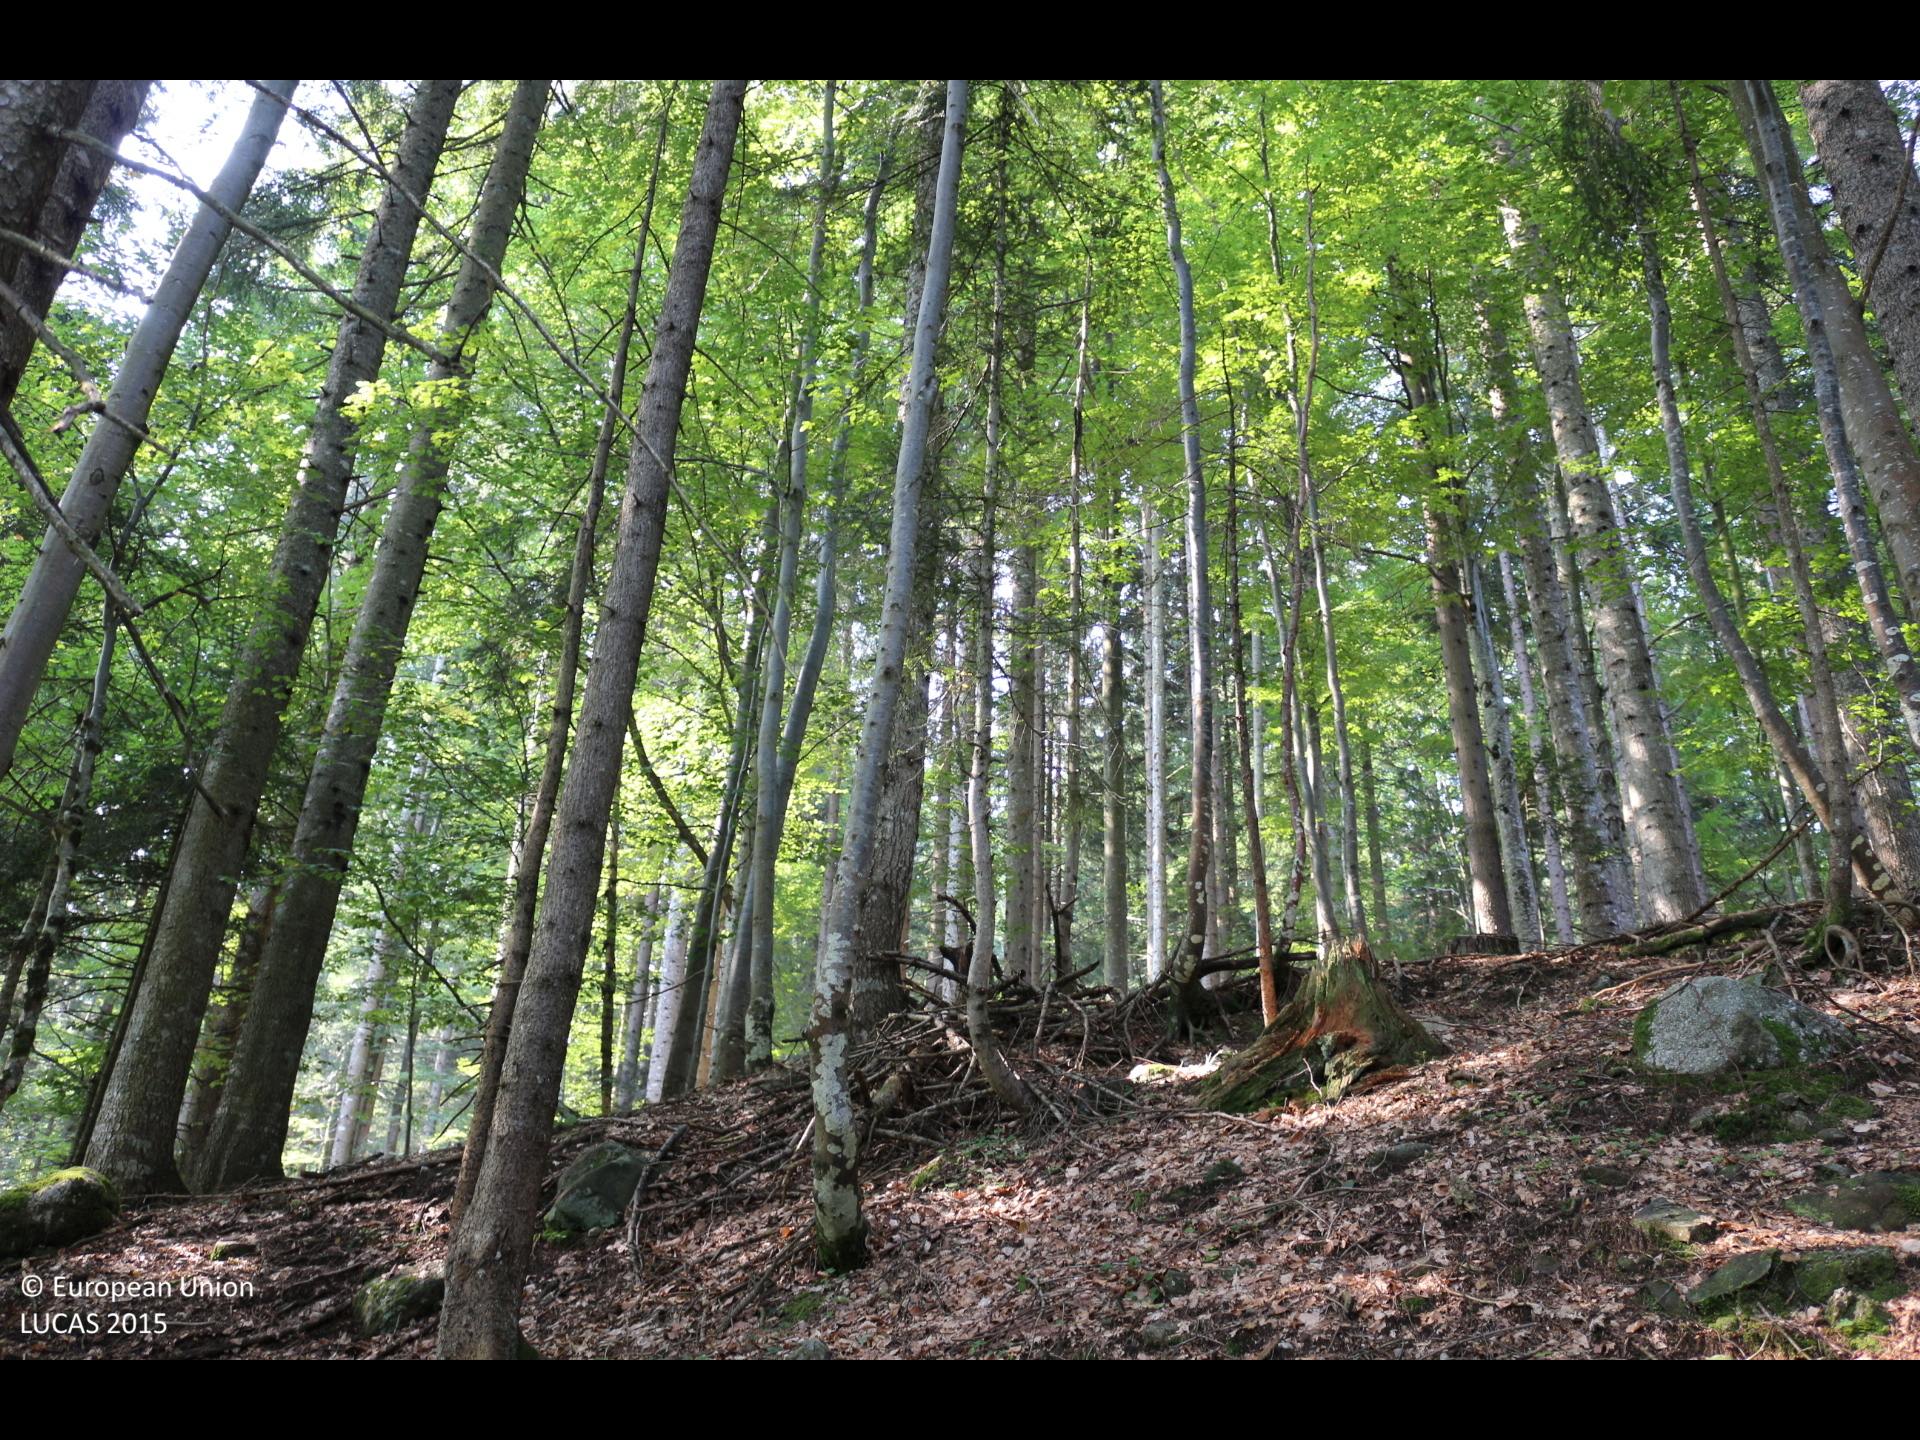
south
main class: Woodland
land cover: Spruce dominated mixed woodland
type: alpine coniferous forest
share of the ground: > 75 %
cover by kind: broadleaved forest trees 55 %, coniferous forest trees 35 %, lichens and mosses 5 %, unconsolidated bare surface 5 %
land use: Forestry
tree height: > 5 m
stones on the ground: < 10 %
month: August
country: AT
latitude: 46.5896
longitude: 13.2731
